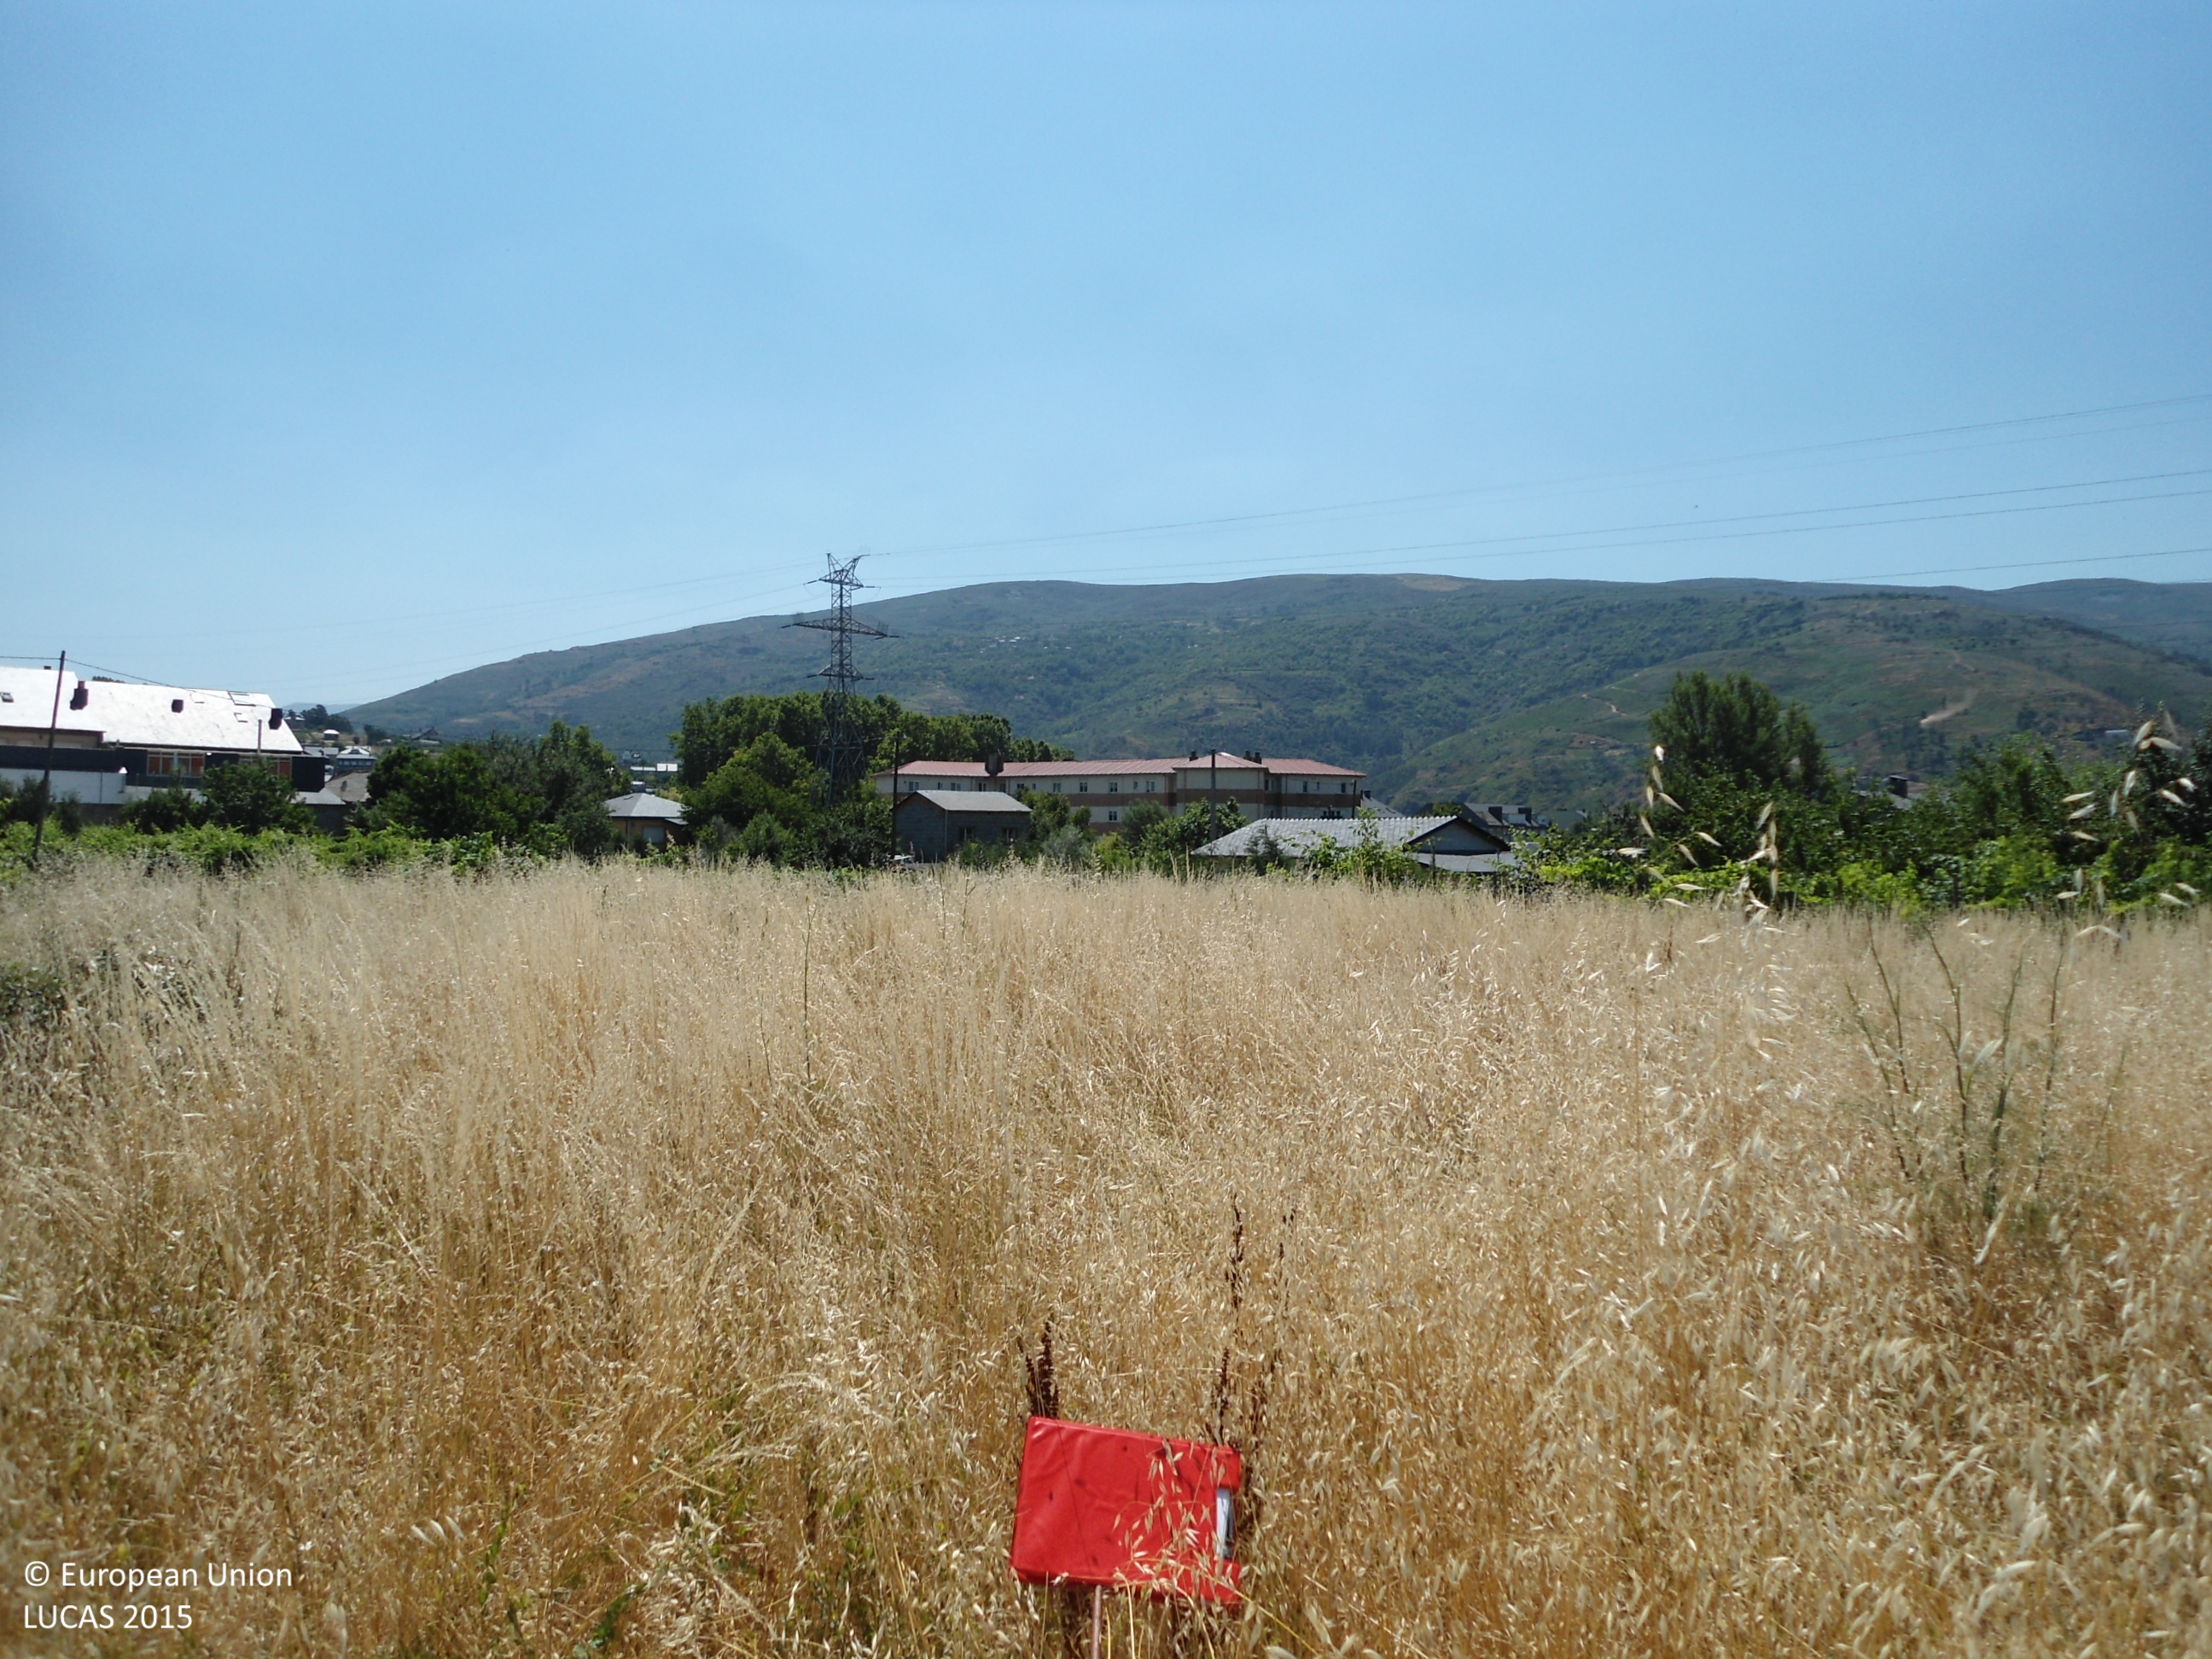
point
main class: Grassland
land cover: Spontaneously vegetated surfaces
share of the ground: > 75 %
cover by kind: herbaceous plants 100 %
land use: Semi-natural and natural areas not in use
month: June
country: ES
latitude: 42.4225
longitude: -6.9844
